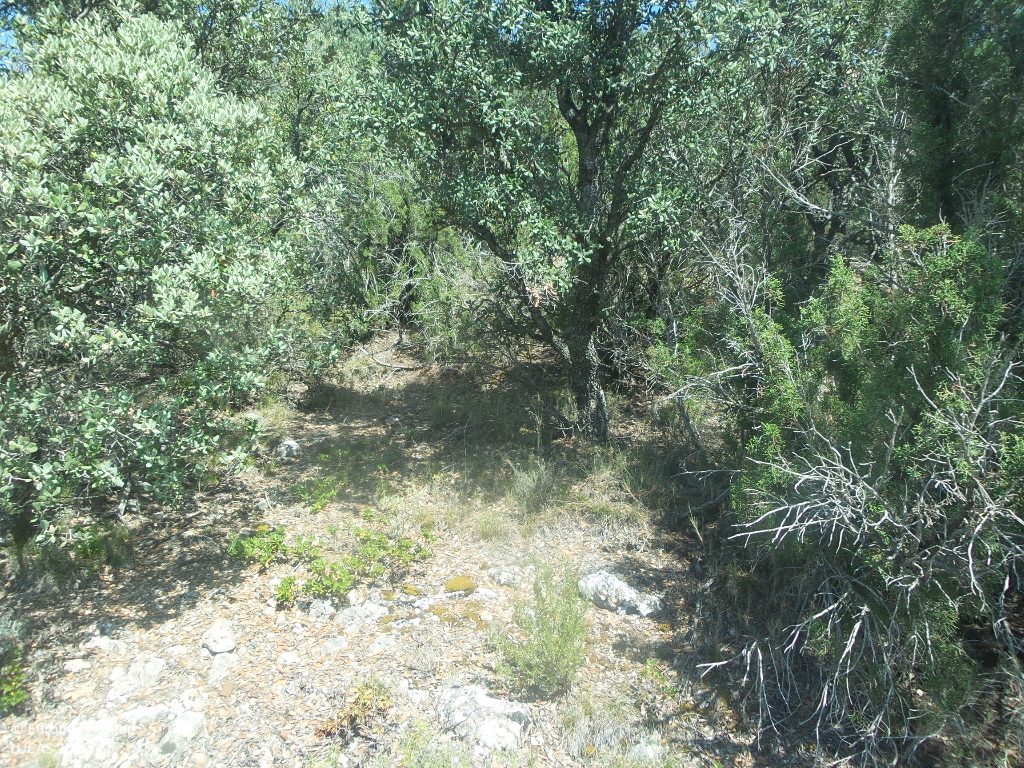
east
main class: Woodland
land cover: Broadleaved woodland
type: broadleaved evergreen forest
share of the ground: > 75 %
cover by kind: broadleaved forest trees 80 %, unconsolidated bare surface 10 %, shrubs 5 %, herbaceous plants 5 %
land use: Semi-natural and natural areas not in use
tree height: > 5 m
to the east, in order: Broadleaved woodland
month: July
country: ES
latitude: 41.1536
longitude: -2.1468
